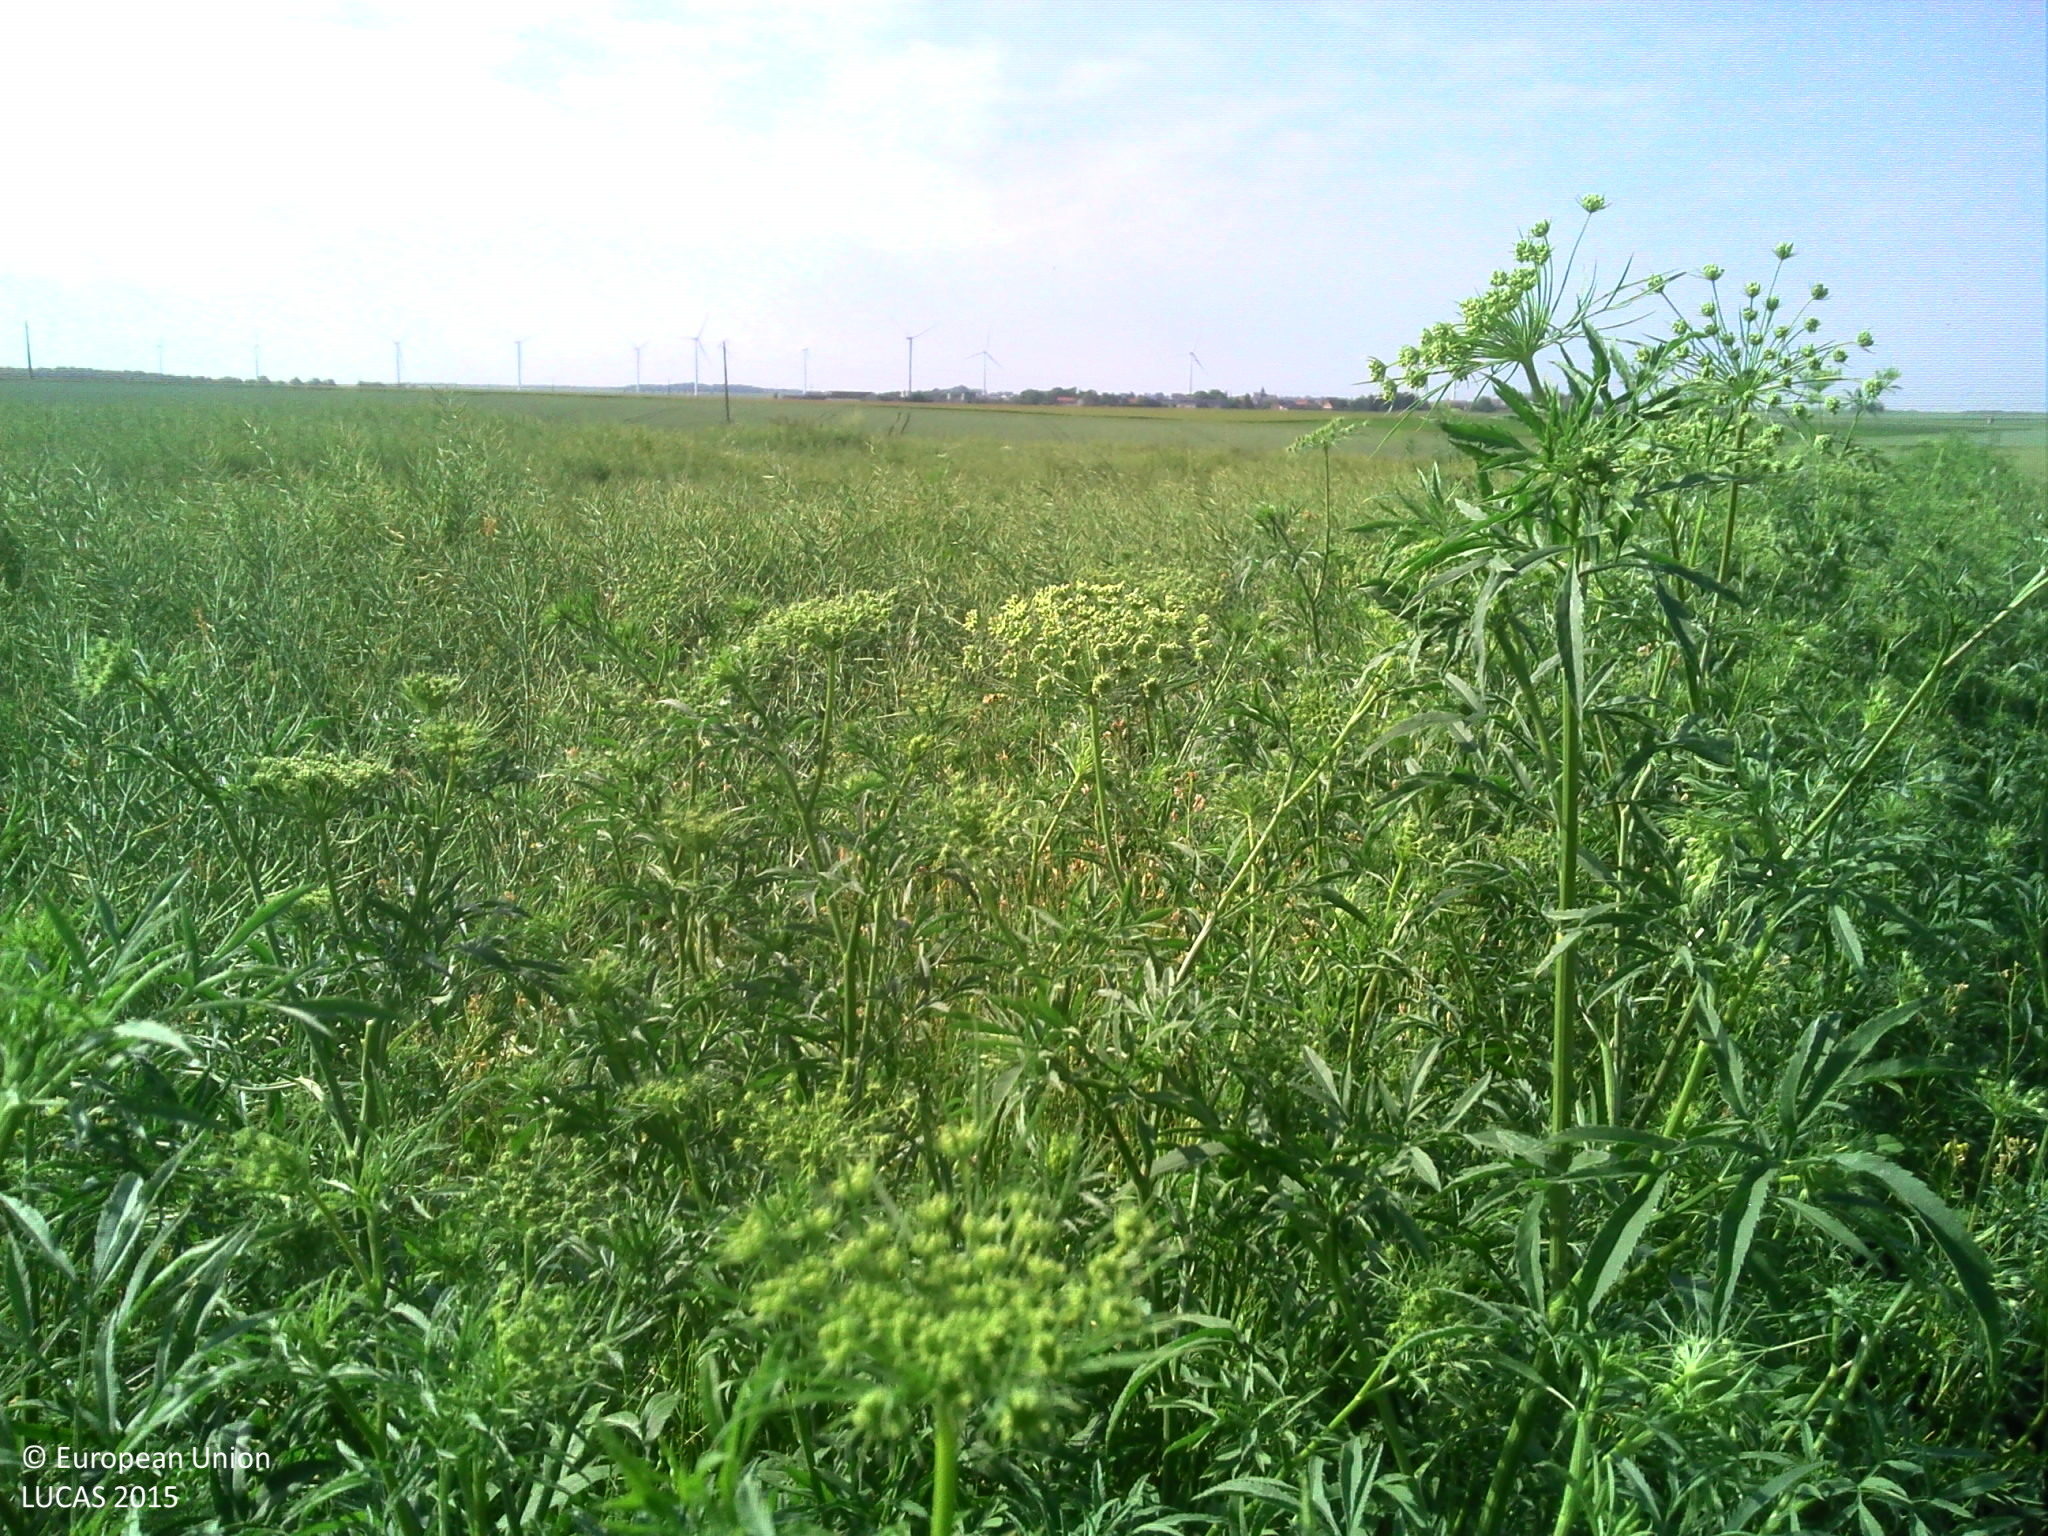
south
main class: Cropland
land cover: Common wheat
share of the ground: > 75 %
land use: Agriculture (excluding fallow land and kitchen gardens)
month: June
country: FR
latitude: 49.7495
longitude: 2.3954
